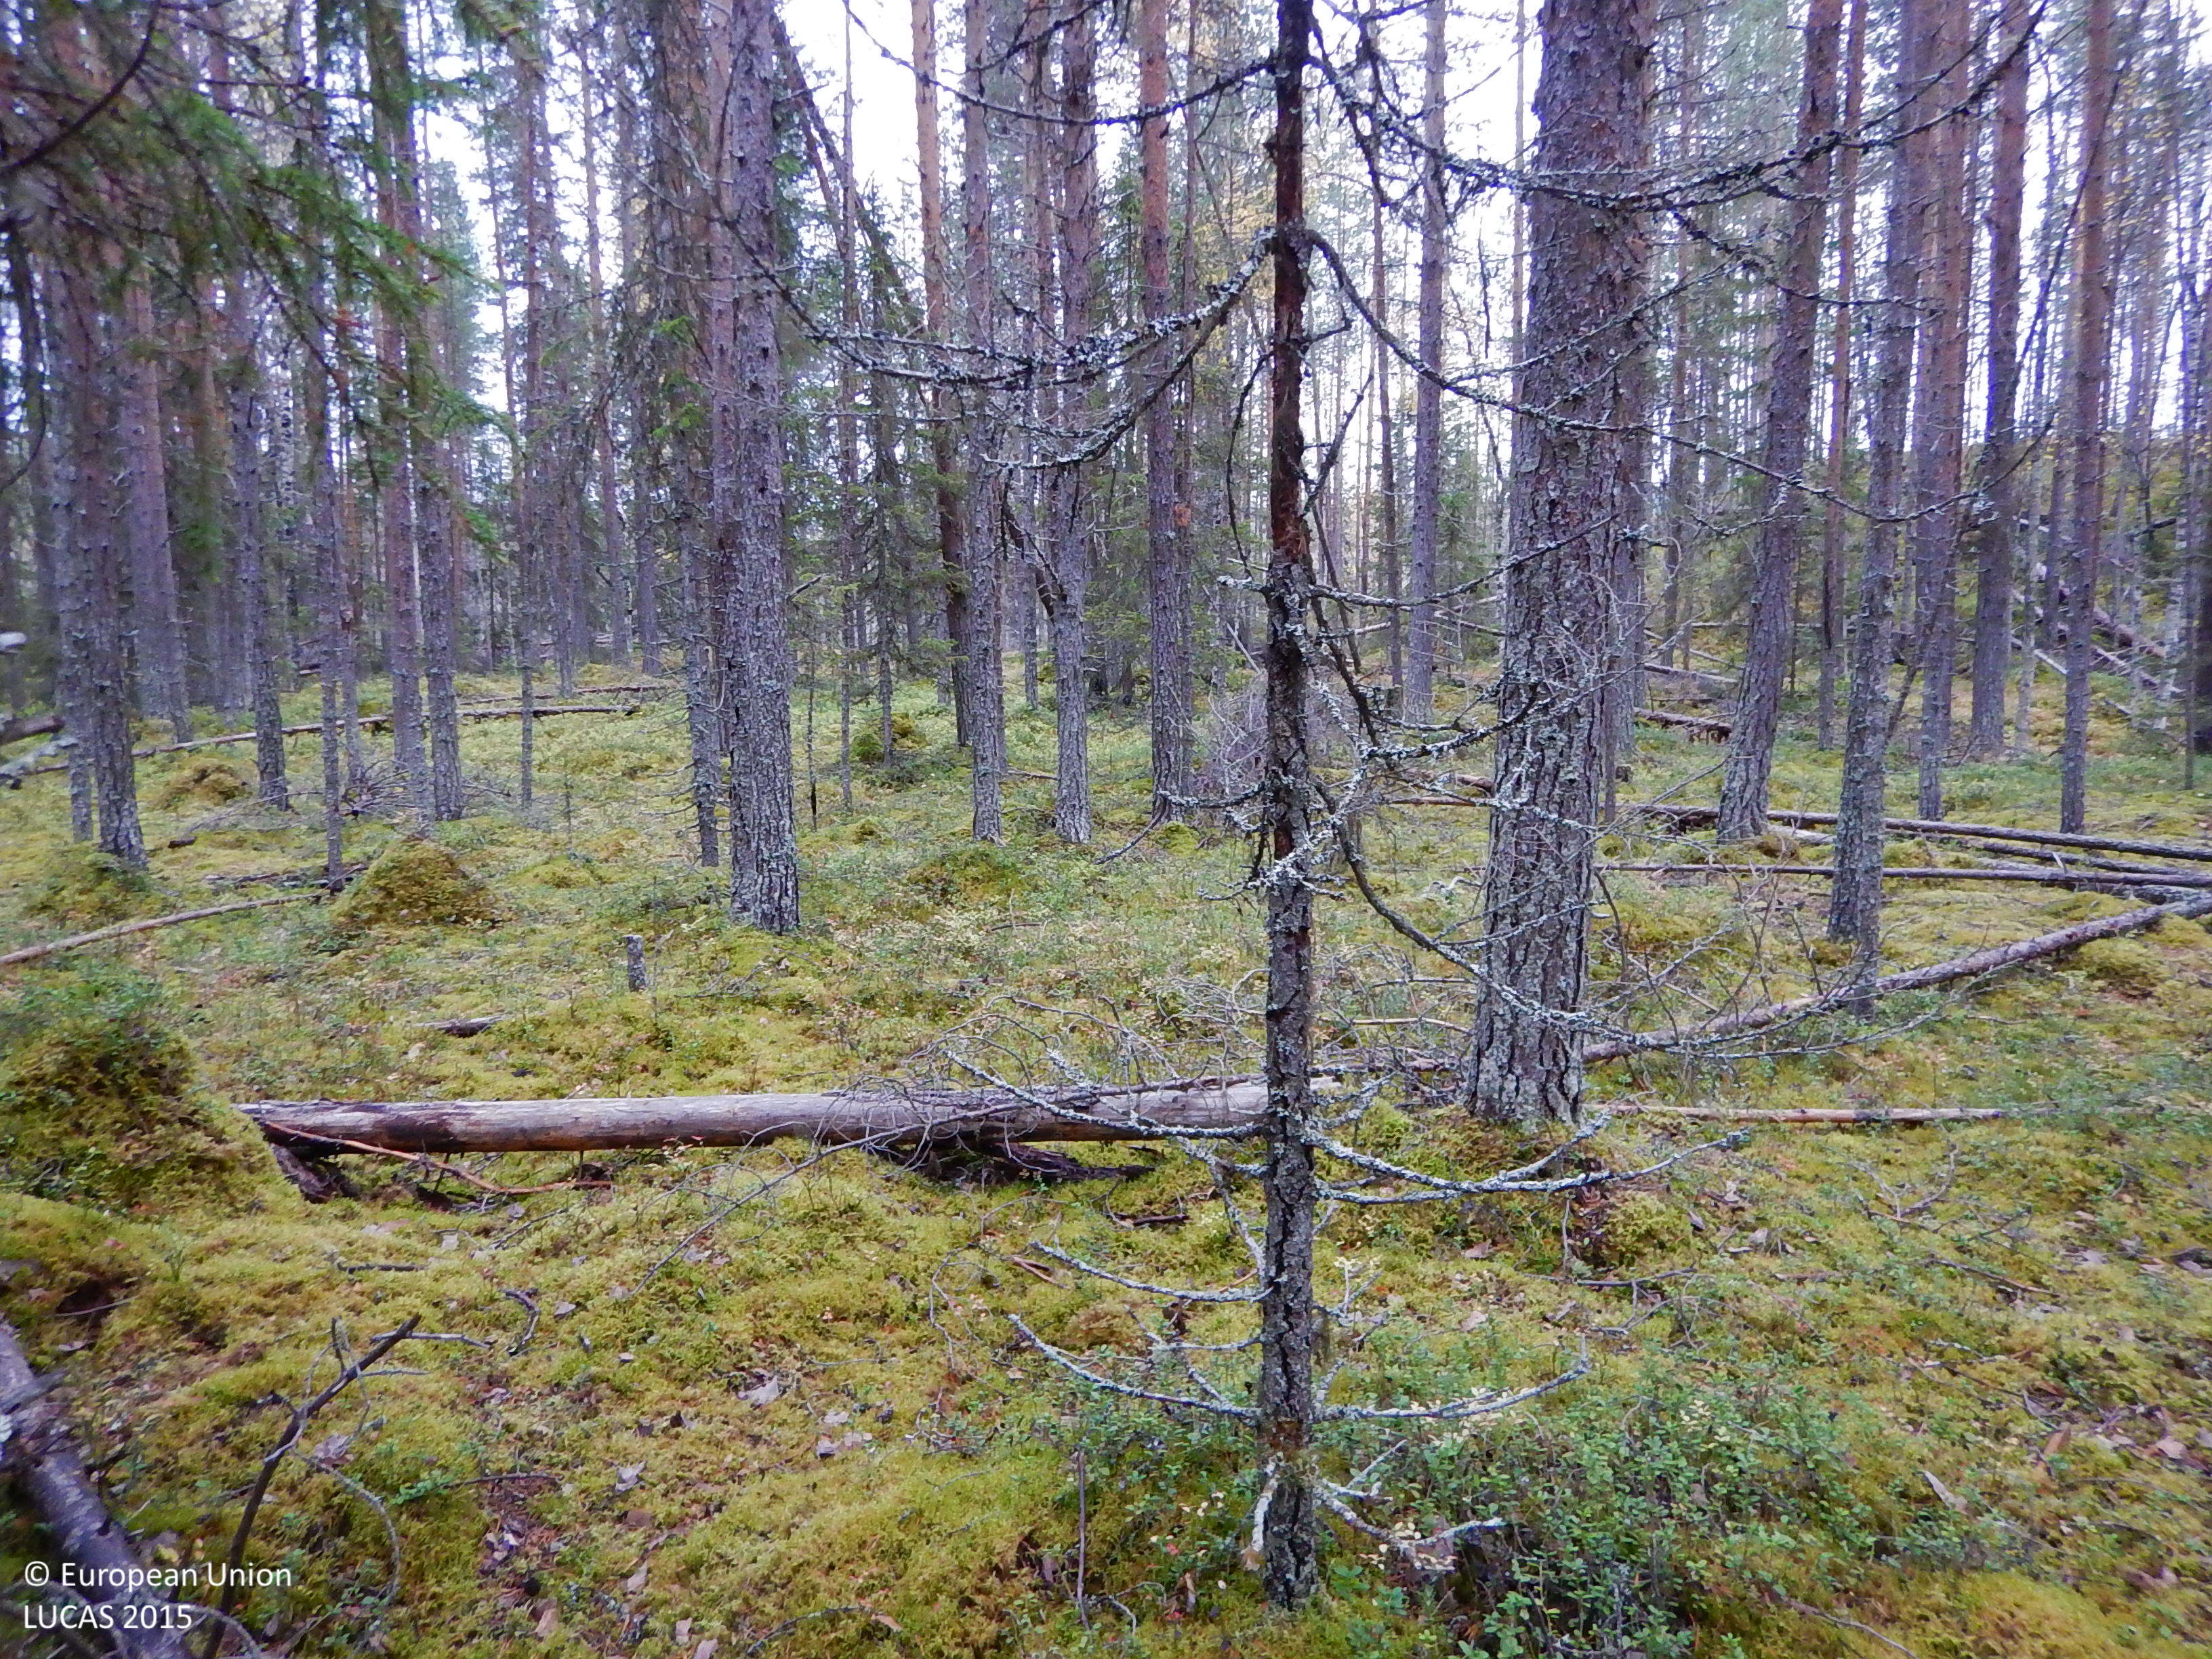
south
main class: Woodland
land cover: Pine dominated coniferous woodland
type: boreal forest
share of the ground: 50 - 75 %
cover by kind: coniferous forest trees 60 %, shrubs 15 %, lichens and mosses 15 %, herbaceous plants 10 %
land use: Forestry
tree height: > 5 m
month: September
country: SE
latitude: 65.0540
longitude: 19.2944
